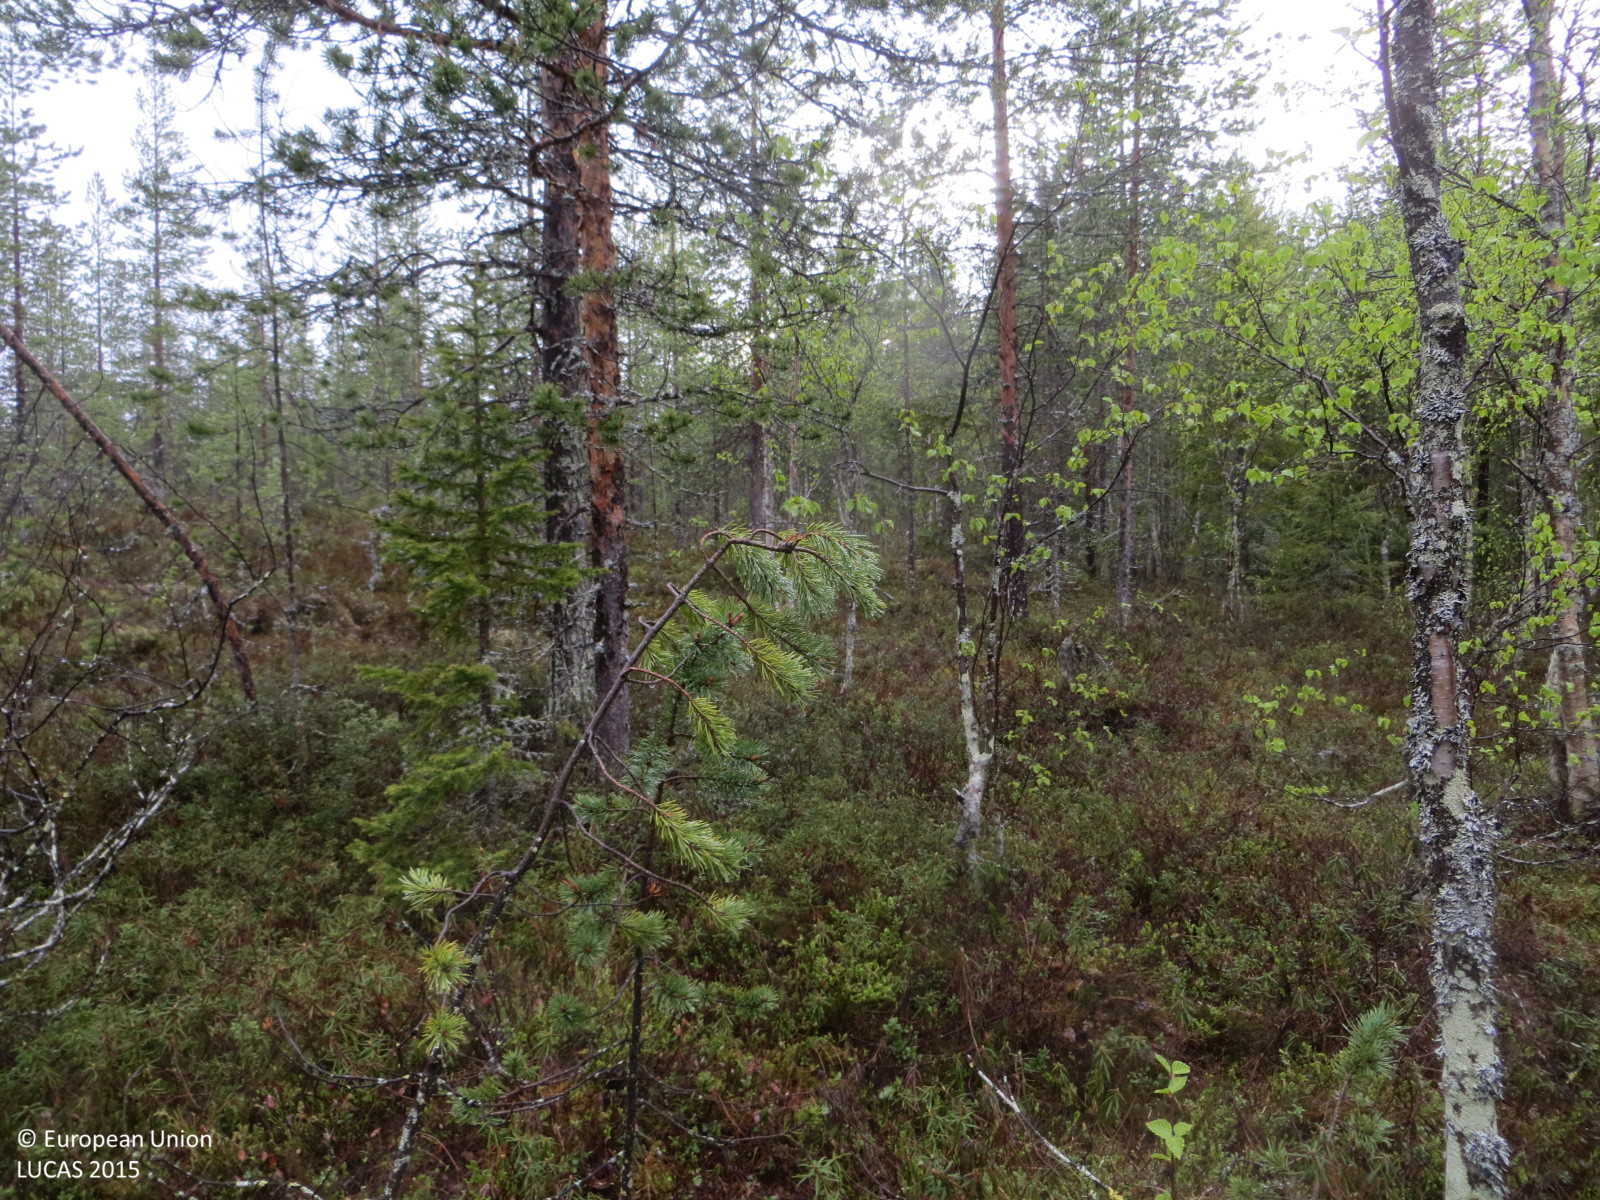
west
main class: Woodland
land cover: Other mixed woodland
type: boreal forest
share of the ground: > 75 %
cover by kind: coniferous forest trees 50 %, broadleaved forest trees 30 %, shrubs 20 %
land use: Forestry
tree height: > 5 m
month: June
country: FI
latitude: 66.8779
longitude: 25.4147
